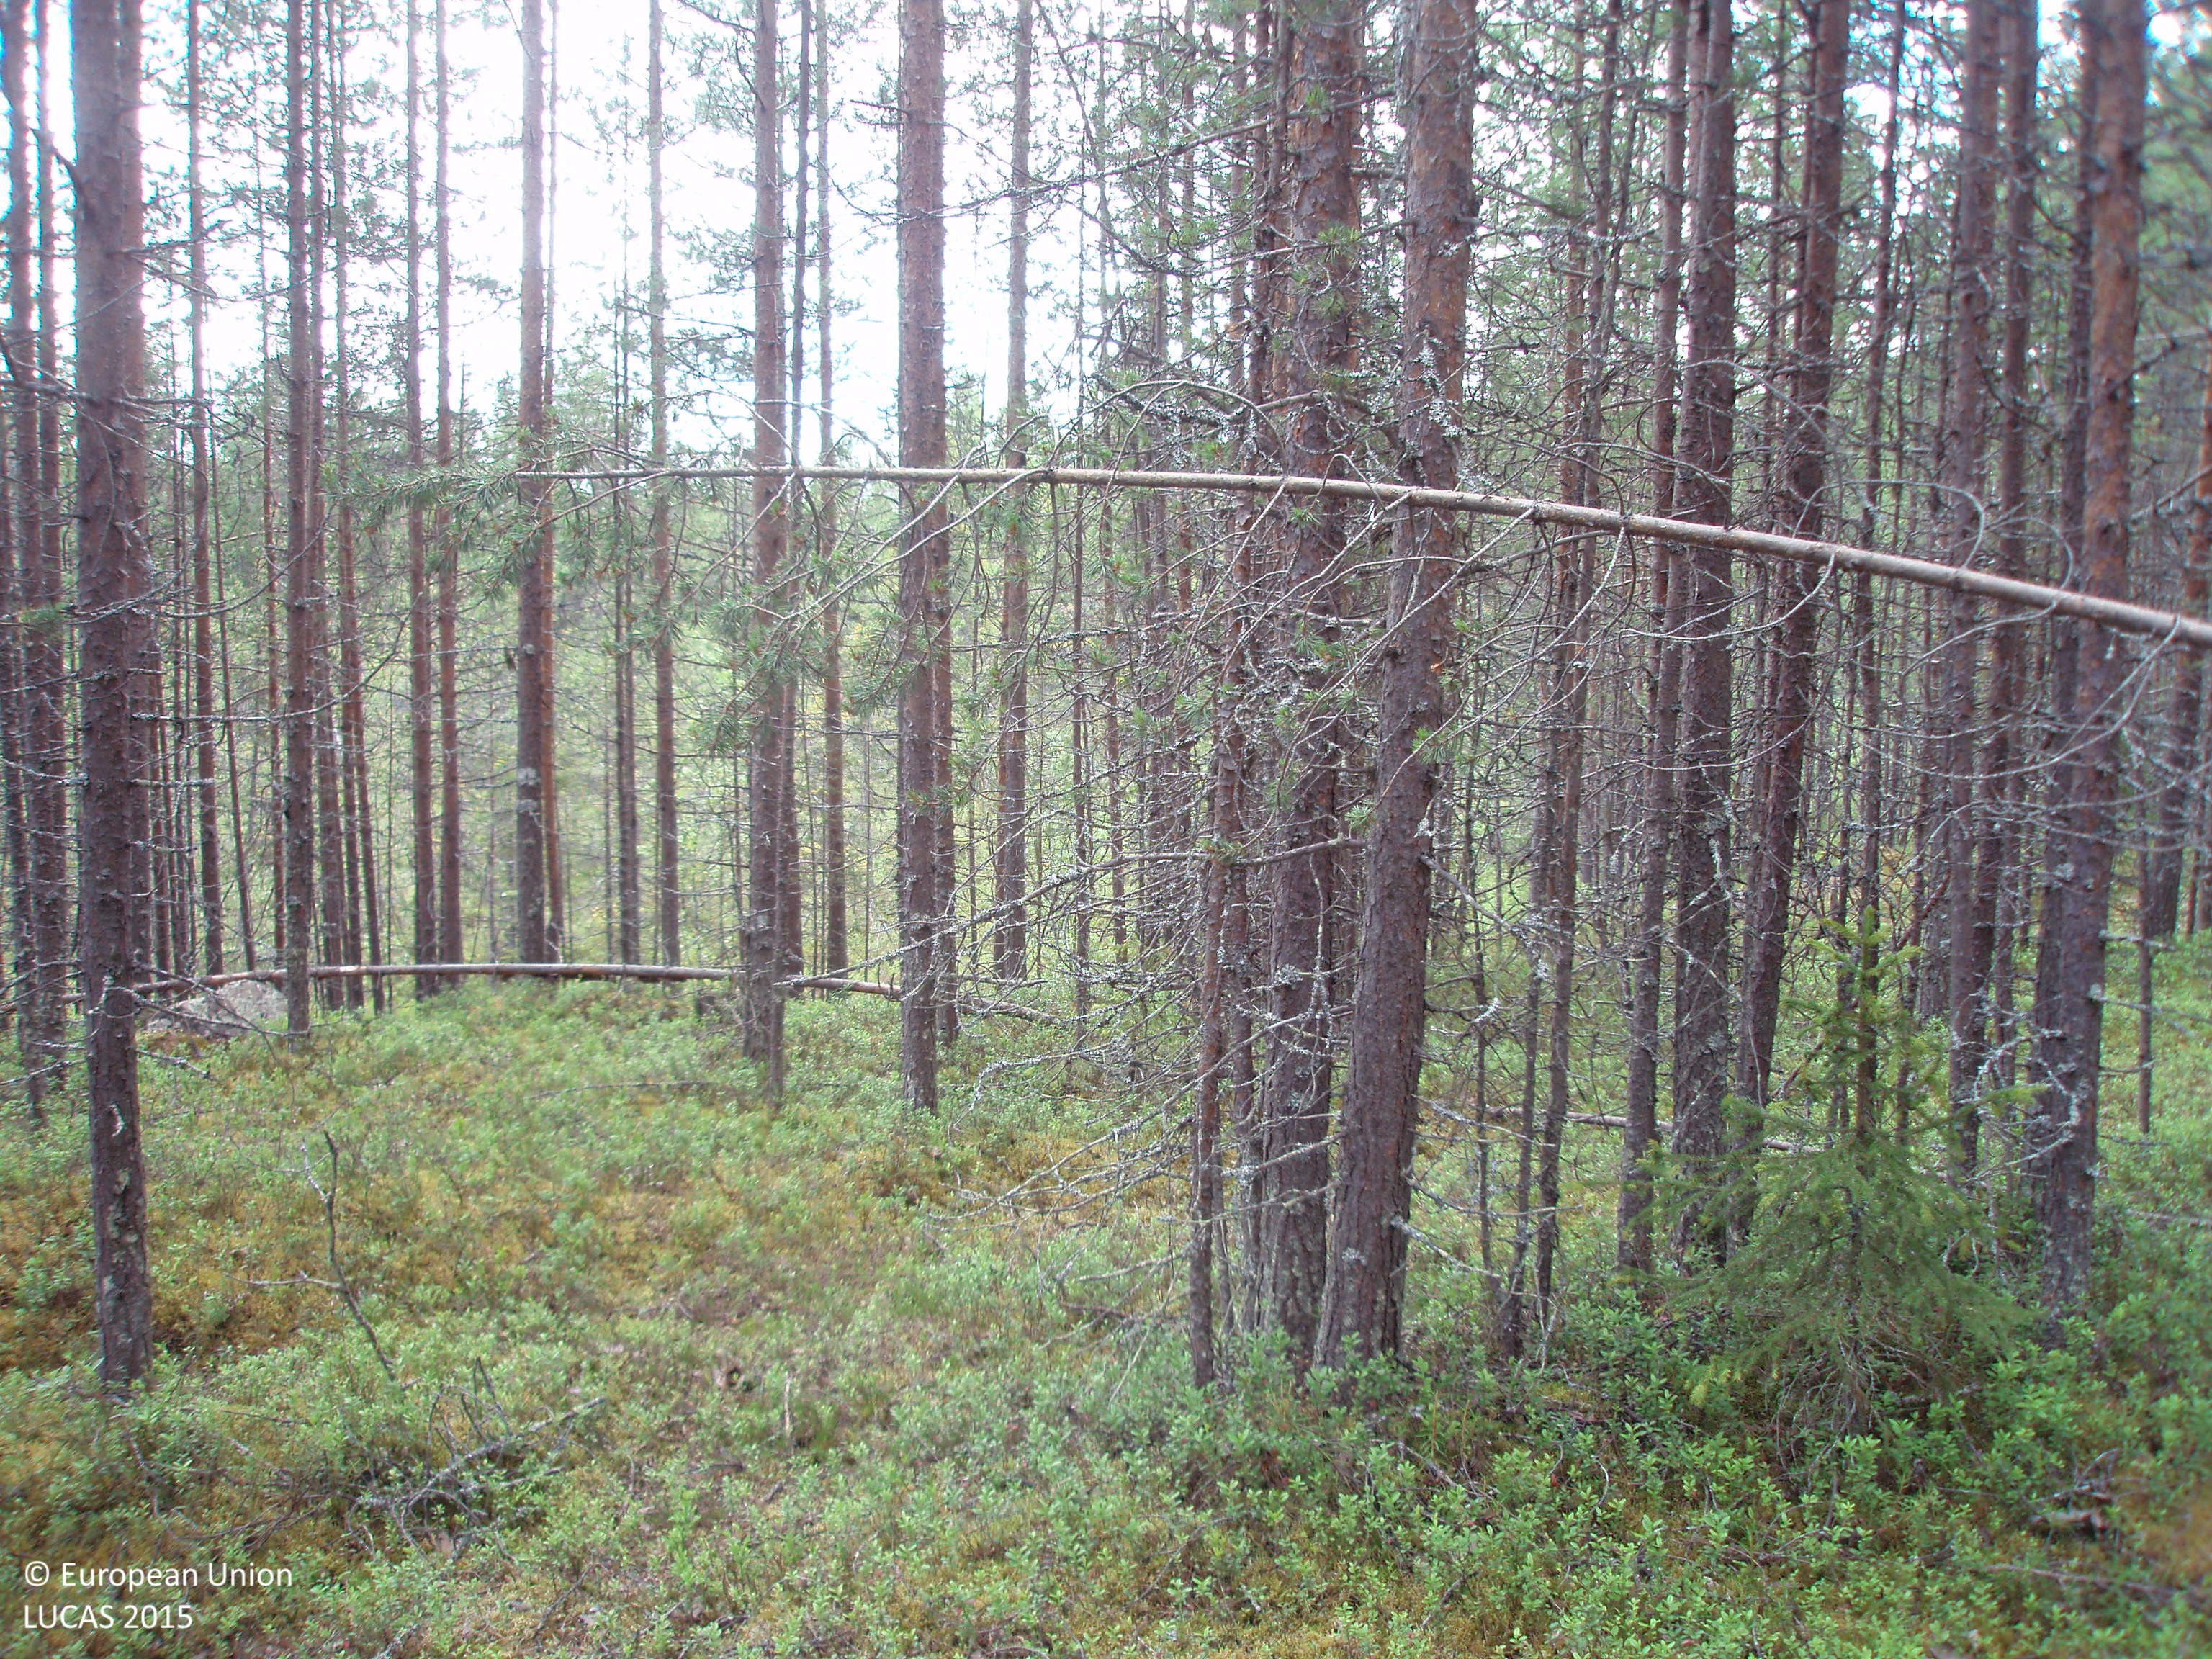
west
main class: Woodland
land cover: Pine dominated coniferous woodland
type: boreal forest
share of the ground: > 75 %
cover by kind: coniferous forest trees 70 %, shrubs 20 %, broadleaved forest trees 5 %, lichens and mosses 5 %
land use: Forestry
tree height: > 5 m
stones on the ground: 10 - 25 %
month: July
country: FI
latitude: 66.8945
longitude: 28.4282
